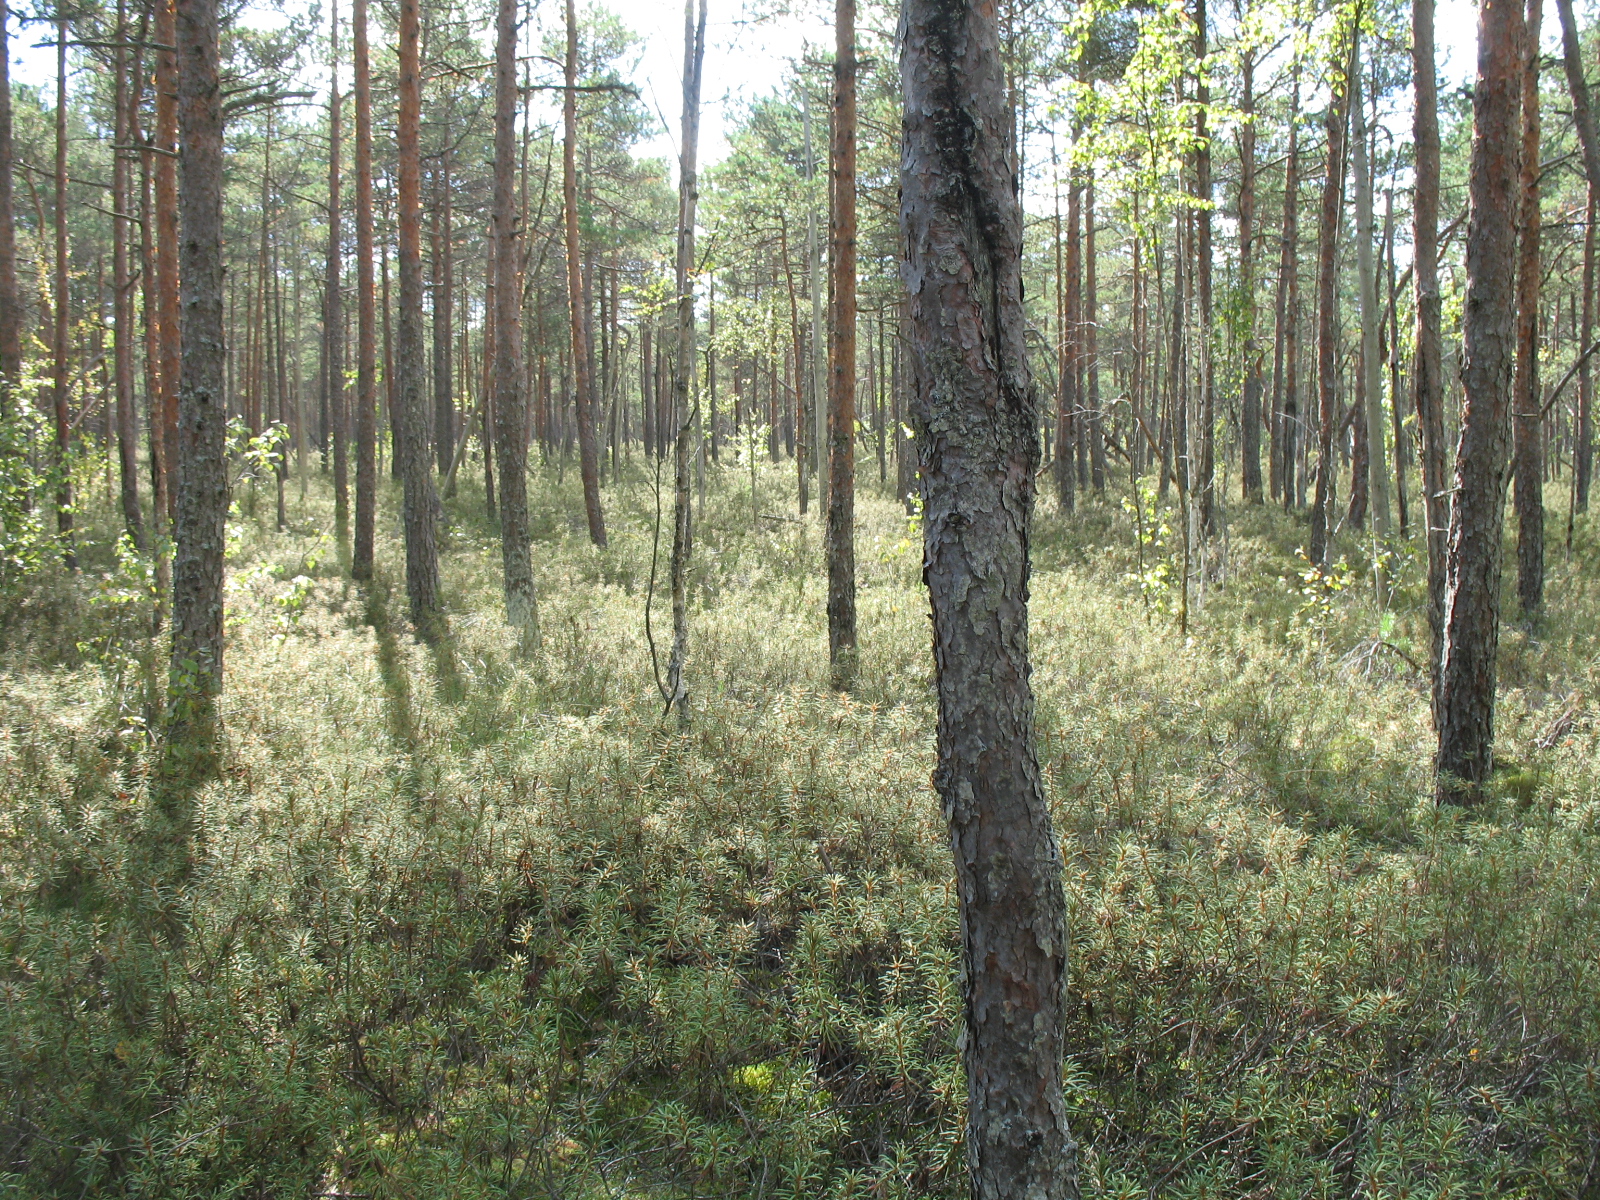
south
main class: Woodland
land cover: Pine dominated coniferous woodland
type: hemiboreal forest and nemoral coniferous forest and mixed broadleaved-coniferous forest
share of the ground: 25 - 50 %
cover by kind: coniferous forest trees 40 %, lichens and mosses 30 %, herbaceous plants 15 %, shrubs 10 %, broadleaved forest trees 5 %
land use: Forestry
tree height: > 5 m
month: September
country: LV
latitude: 56.1631
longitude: 25.4337
